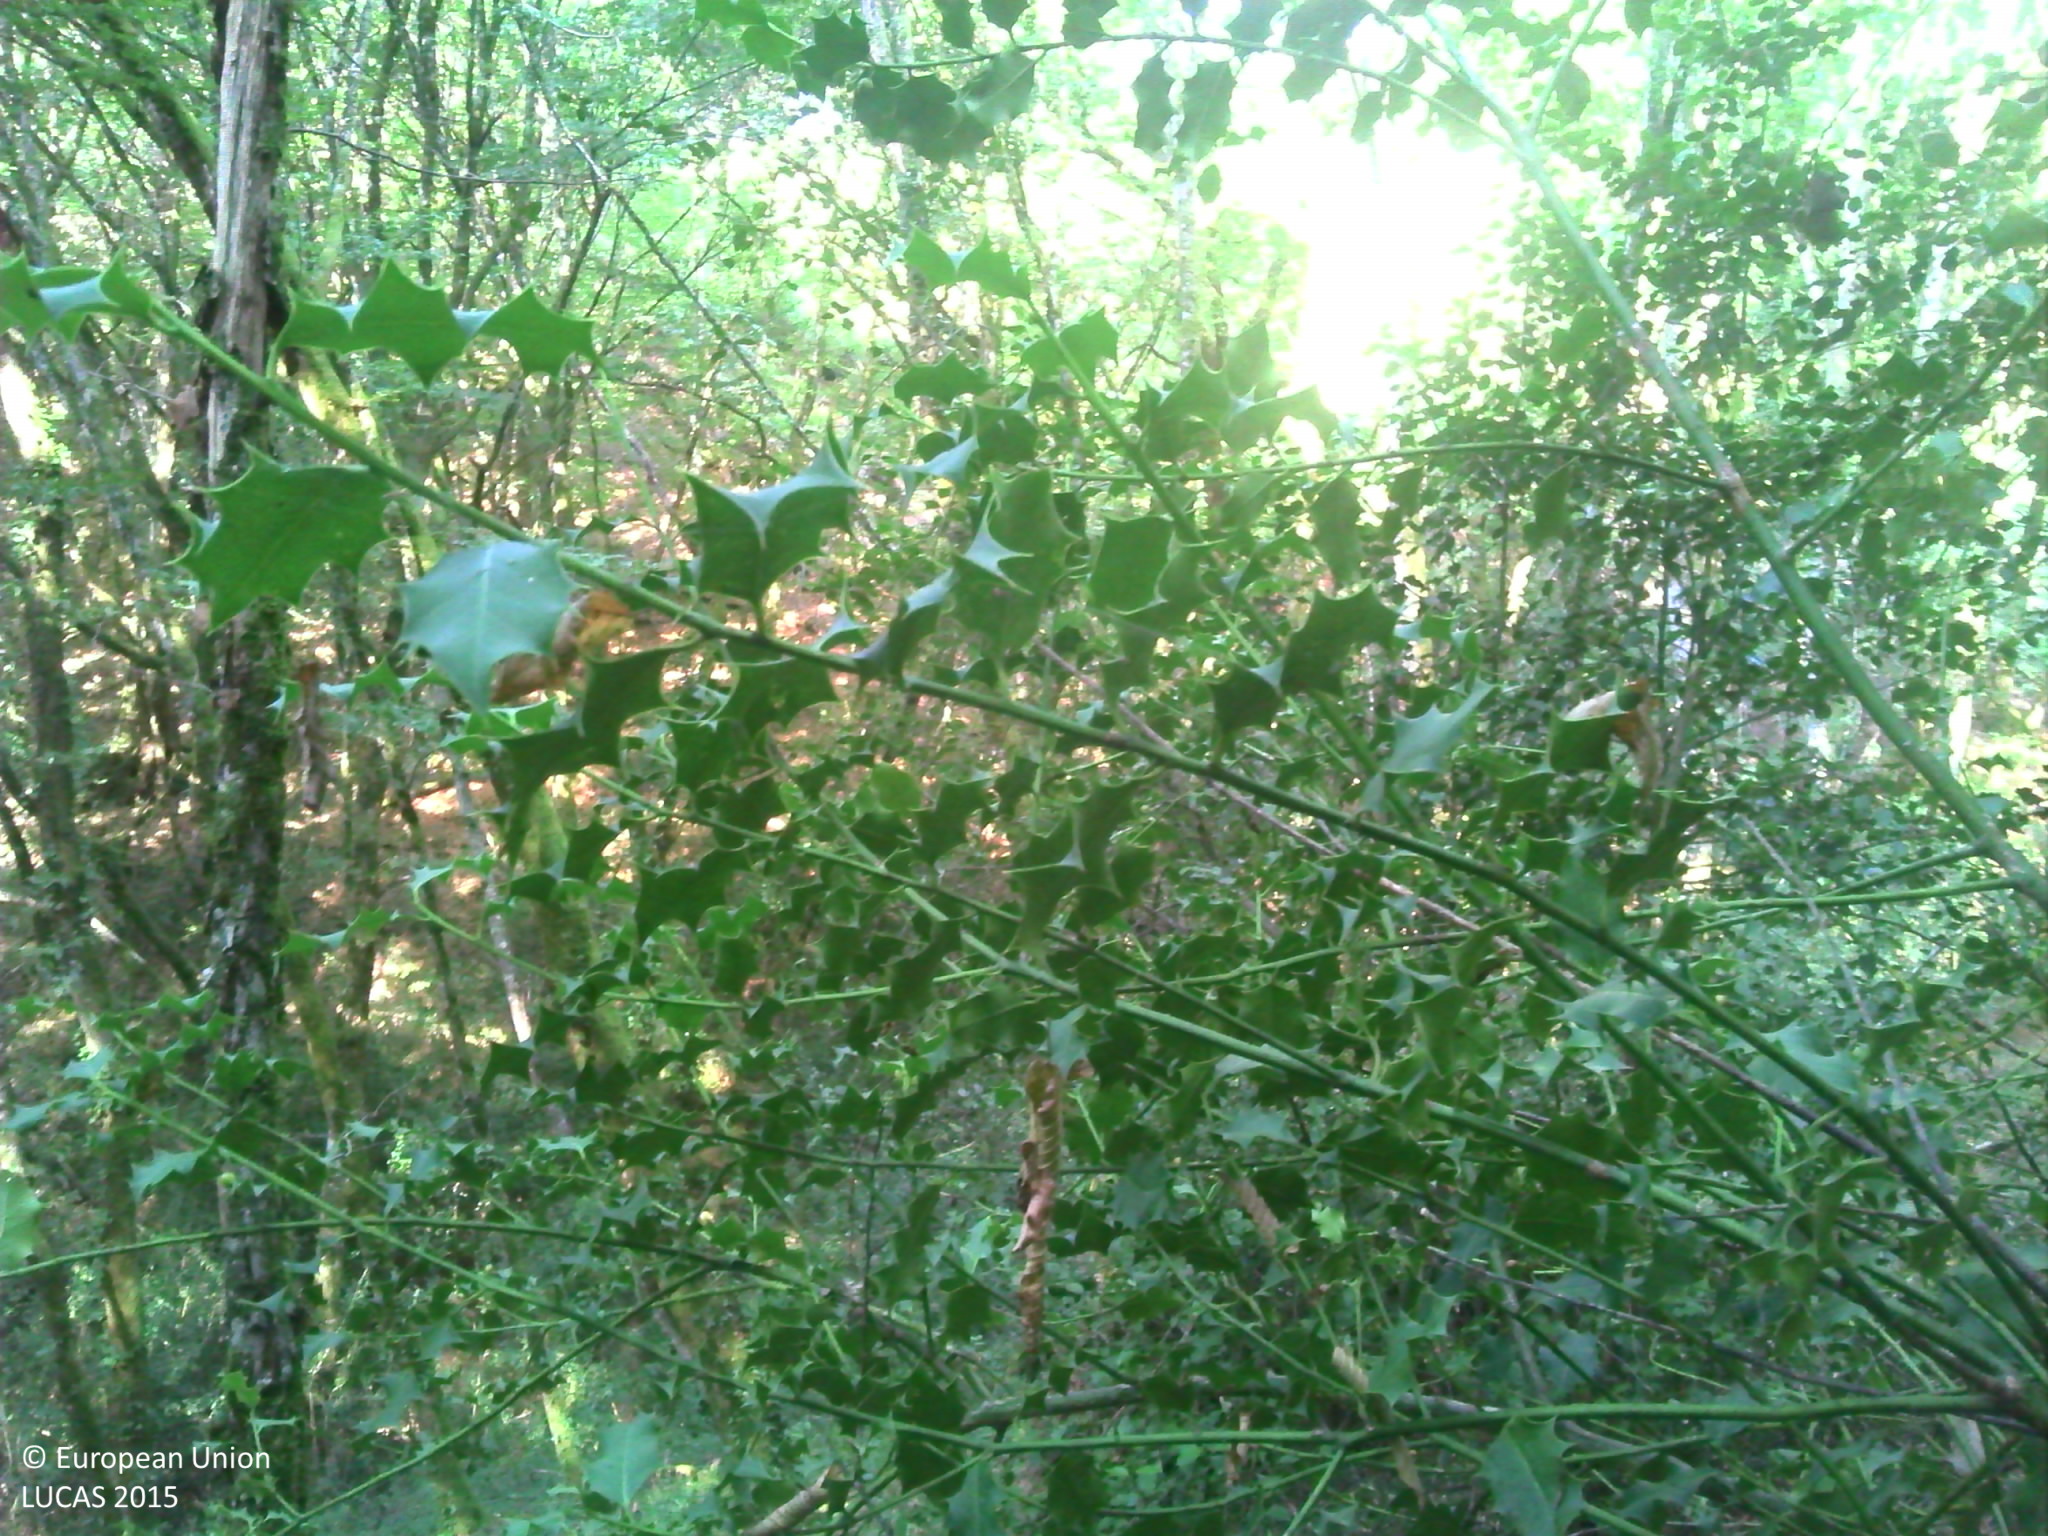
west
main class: Woodland
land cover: Broadleaved woodland
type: mesophytic deciduous forest
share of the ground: 50 - 75 %
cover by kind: broadleaved forest trees 80 %, herbaceous plants 20 %
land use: Forestry
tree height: > 5 m
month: August
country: FR
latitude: 45.3690
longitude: 1.8372
